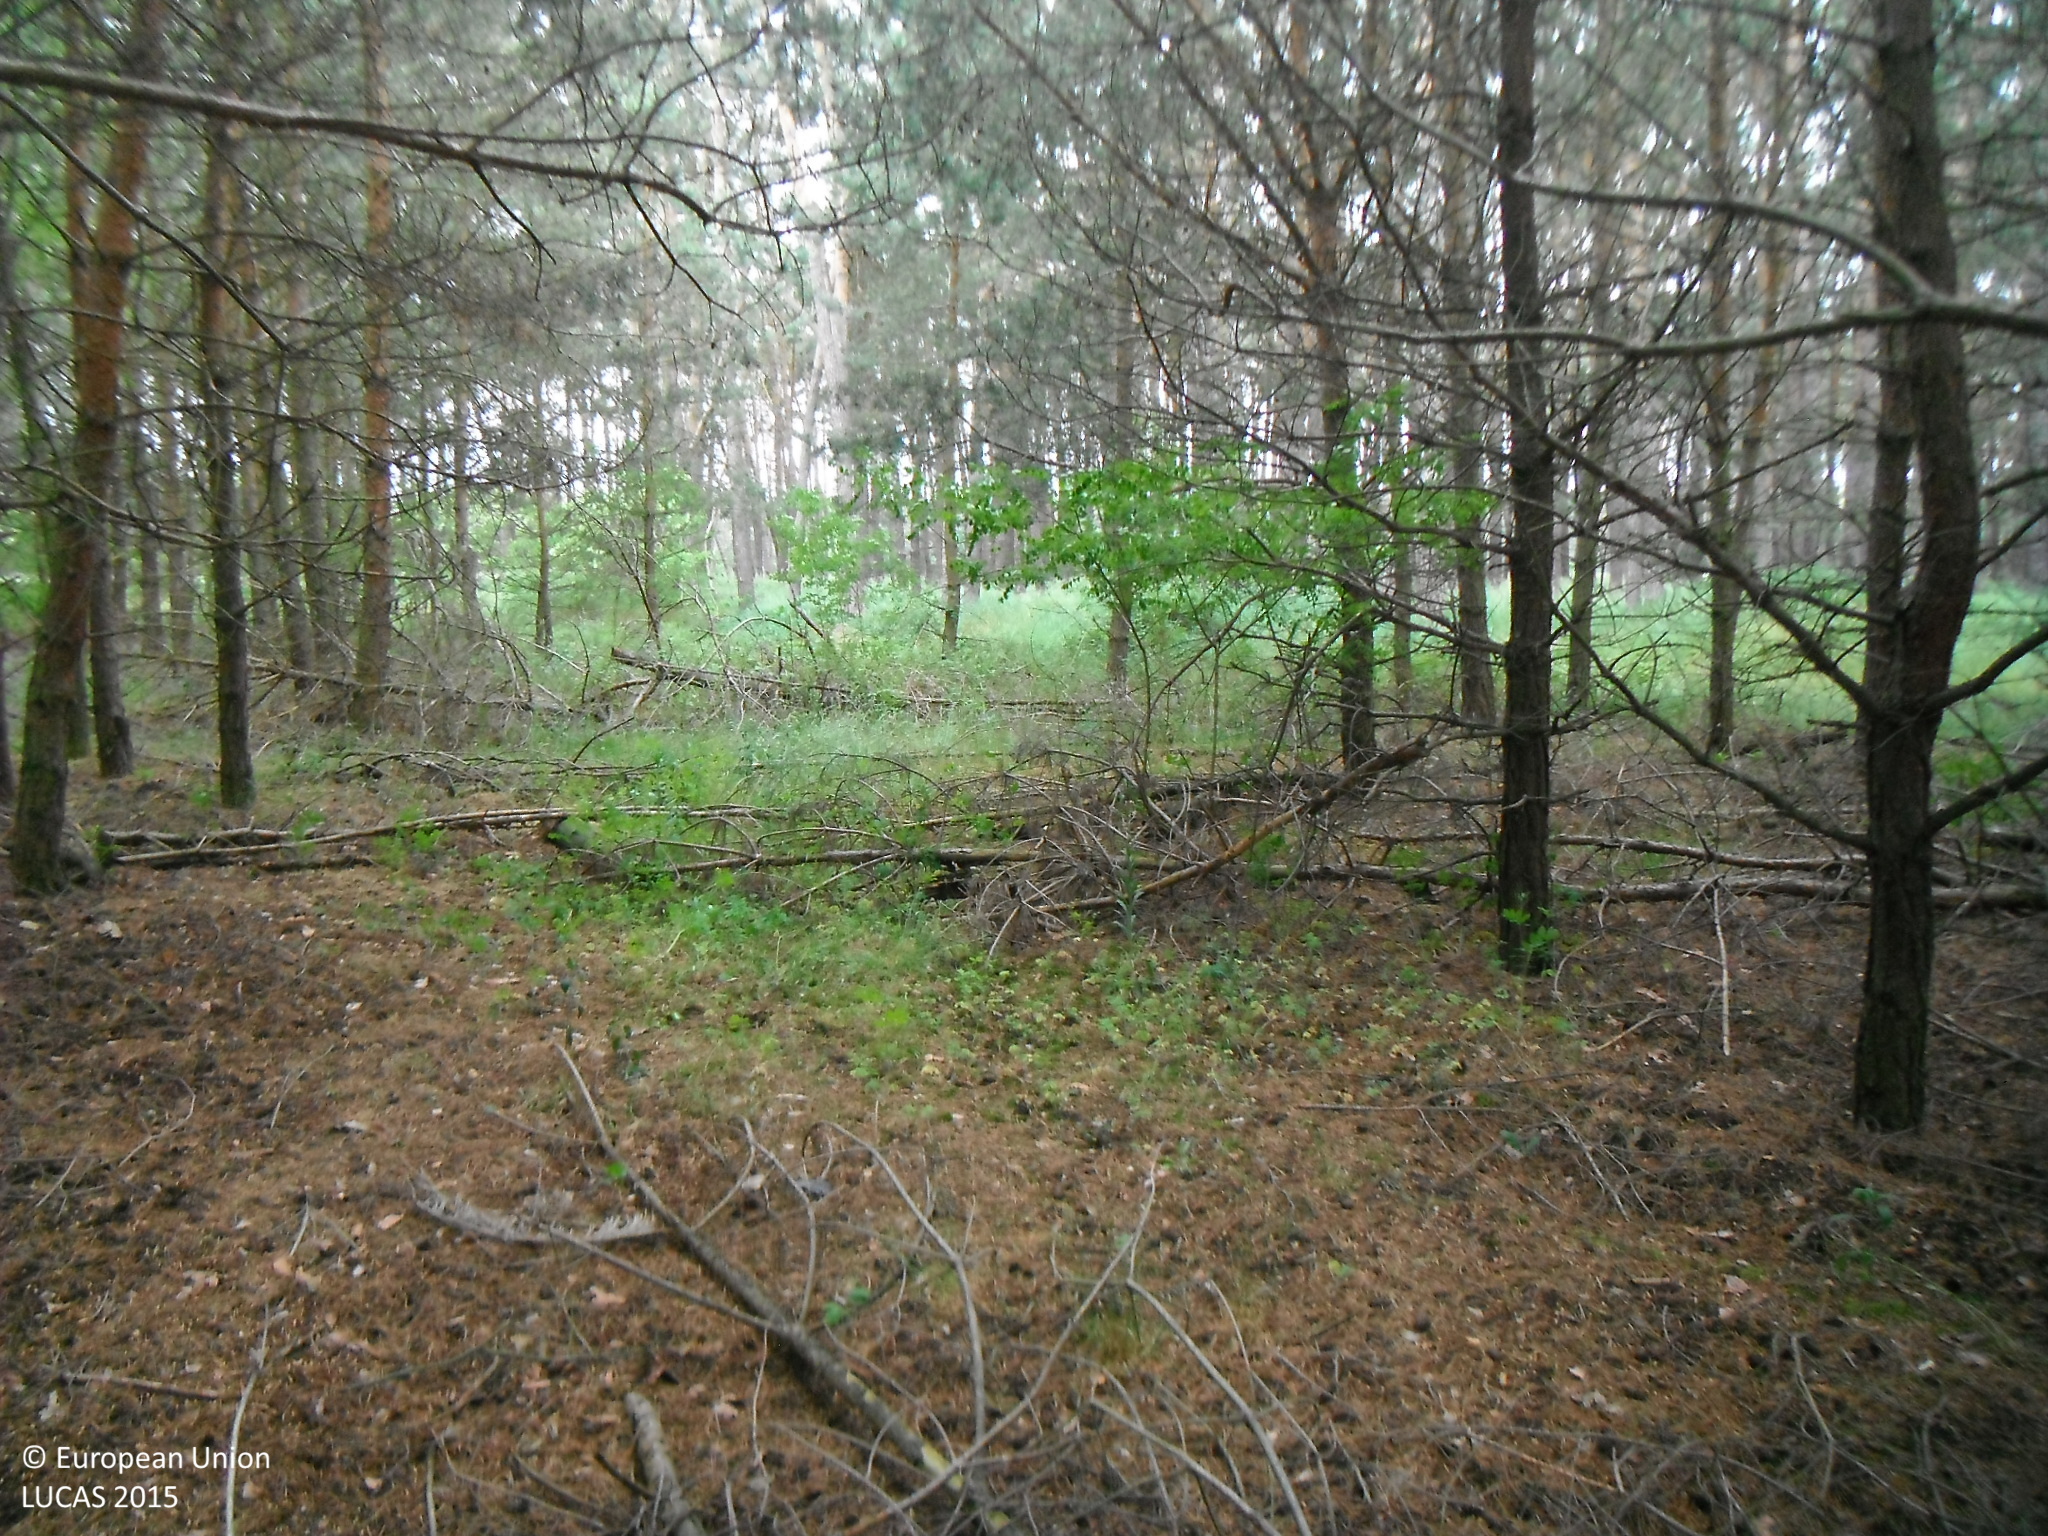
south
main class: Woodland
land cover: Pine dominated coniferous woodland
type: hemiboreal forest and nemoral coniferous forest and mixed broadleaved-coniferous forest
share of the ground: > 75 %
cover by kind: coniferous forest trees 95 %, herbaceous plants 5 %
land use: Forestry
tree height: > 5 m
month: May
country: SK
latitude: 48.3451
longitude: 16.9835
